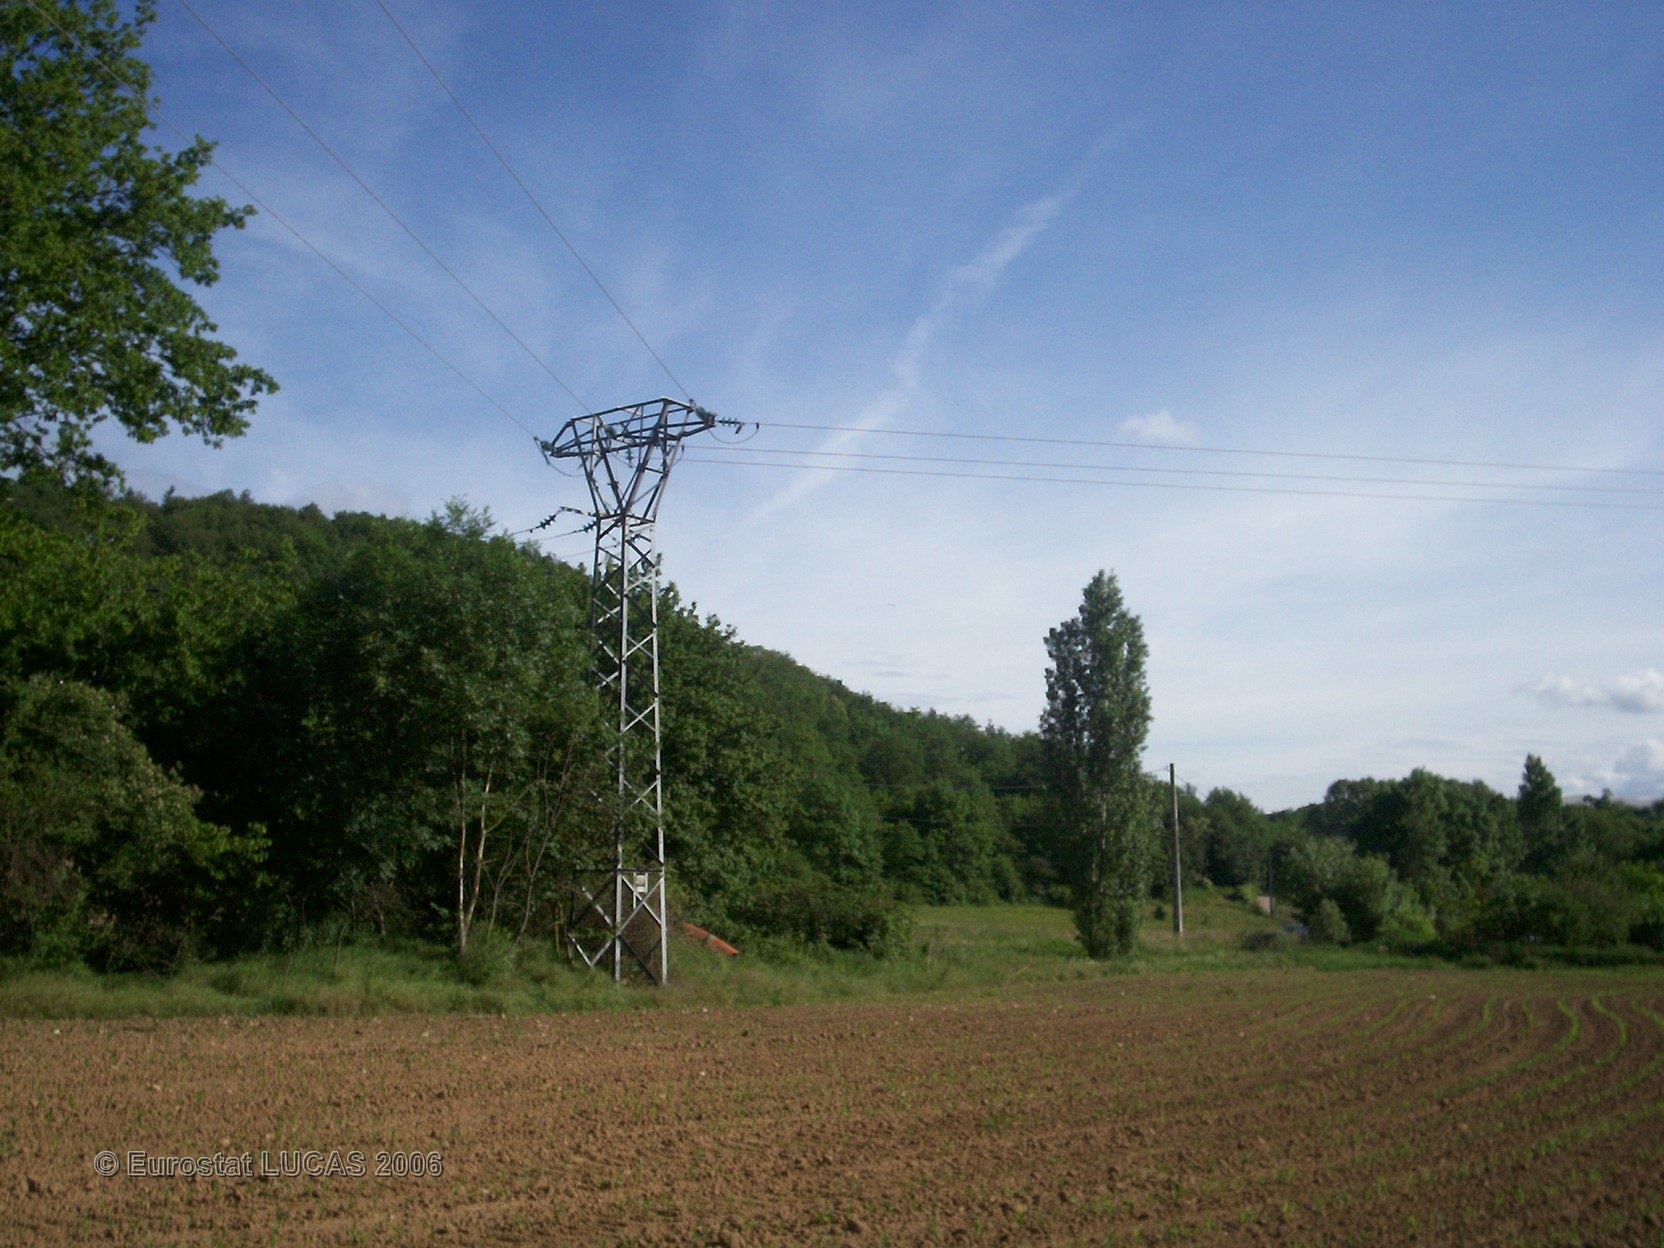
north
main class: Cropland
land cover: Maize
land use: Agriculture (excluding fallow land and kitchen gardens)
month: May
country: FR
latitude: 45.6090
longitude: 4.7595
